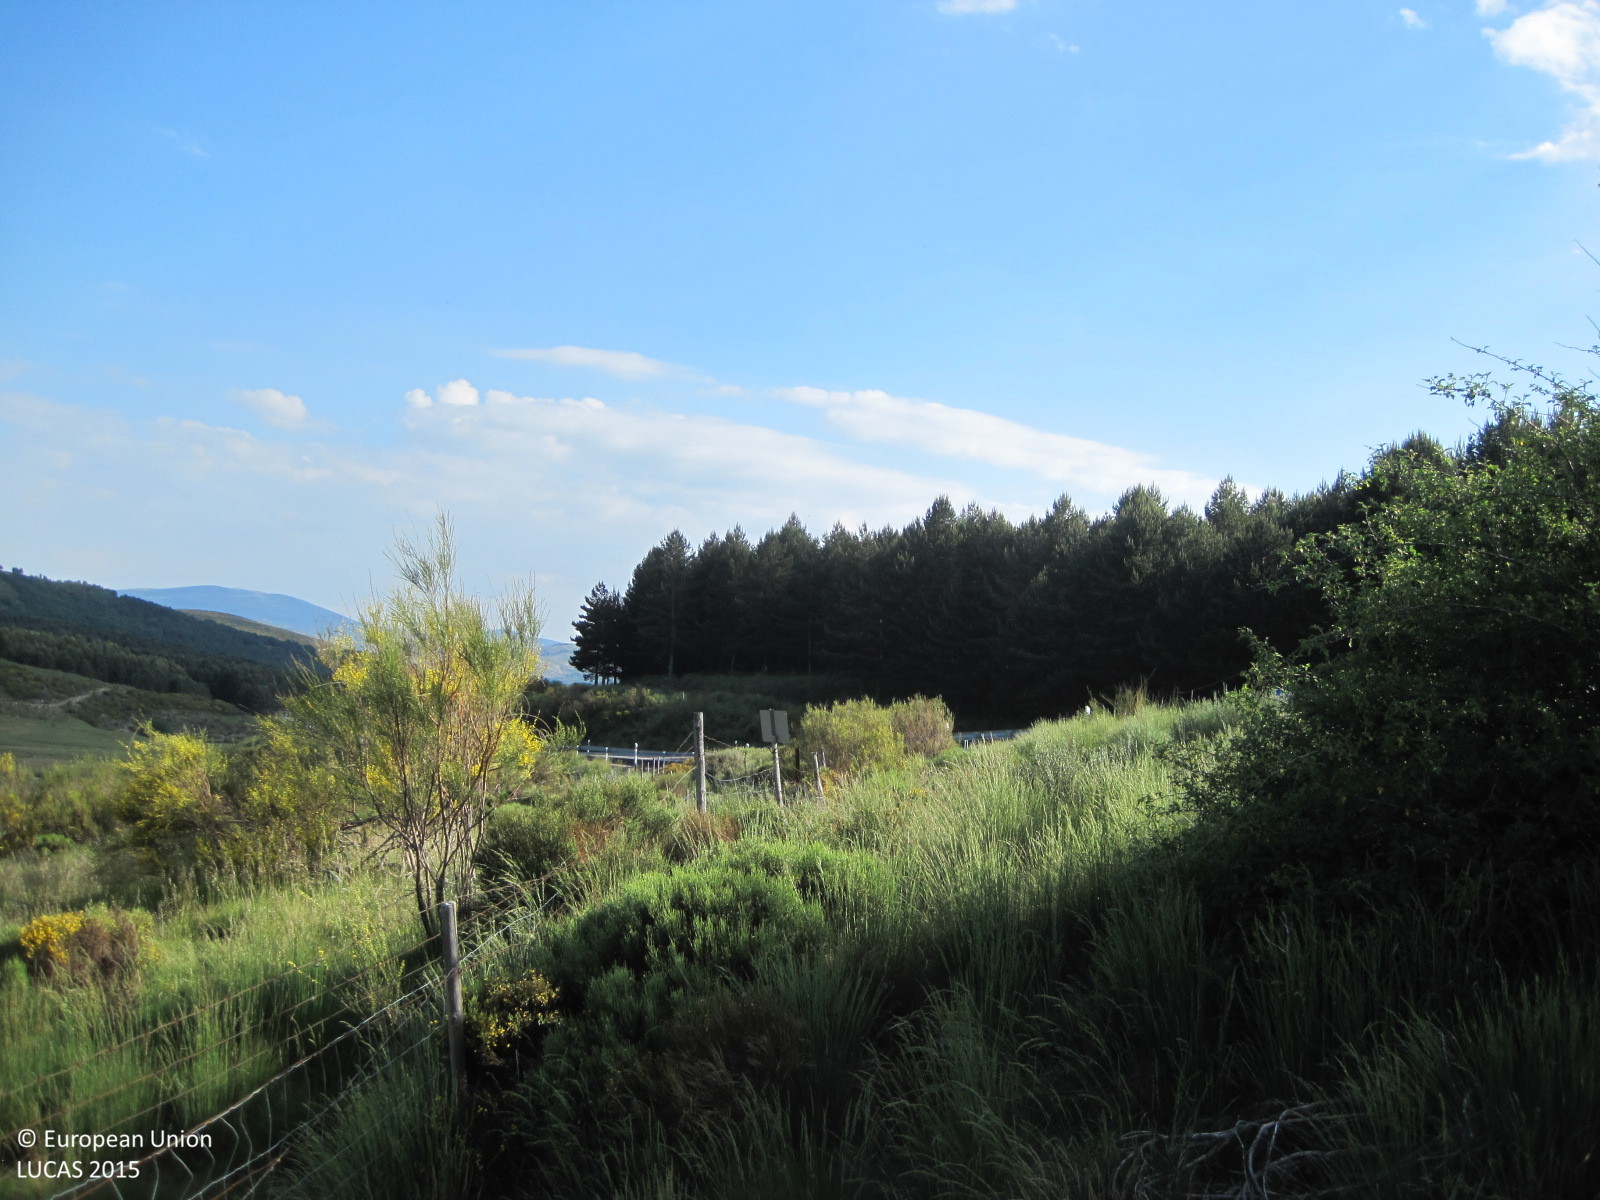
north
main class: Woodland
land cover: Pine dominated coniferous woodland
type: coniferous forest of the mediterranean region
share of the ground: > 75 %
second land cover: Grassland without tree/shrub cover
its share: 50 - 75 %
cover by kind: coniferous forest trees 95 %, herbaceous plants 5 %
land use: Forestry
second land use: Agriculture (excluding fallow land and kitchen gardens)
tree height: > 5 m
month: June
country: ES
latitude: 40.3345
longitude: -5.0171
